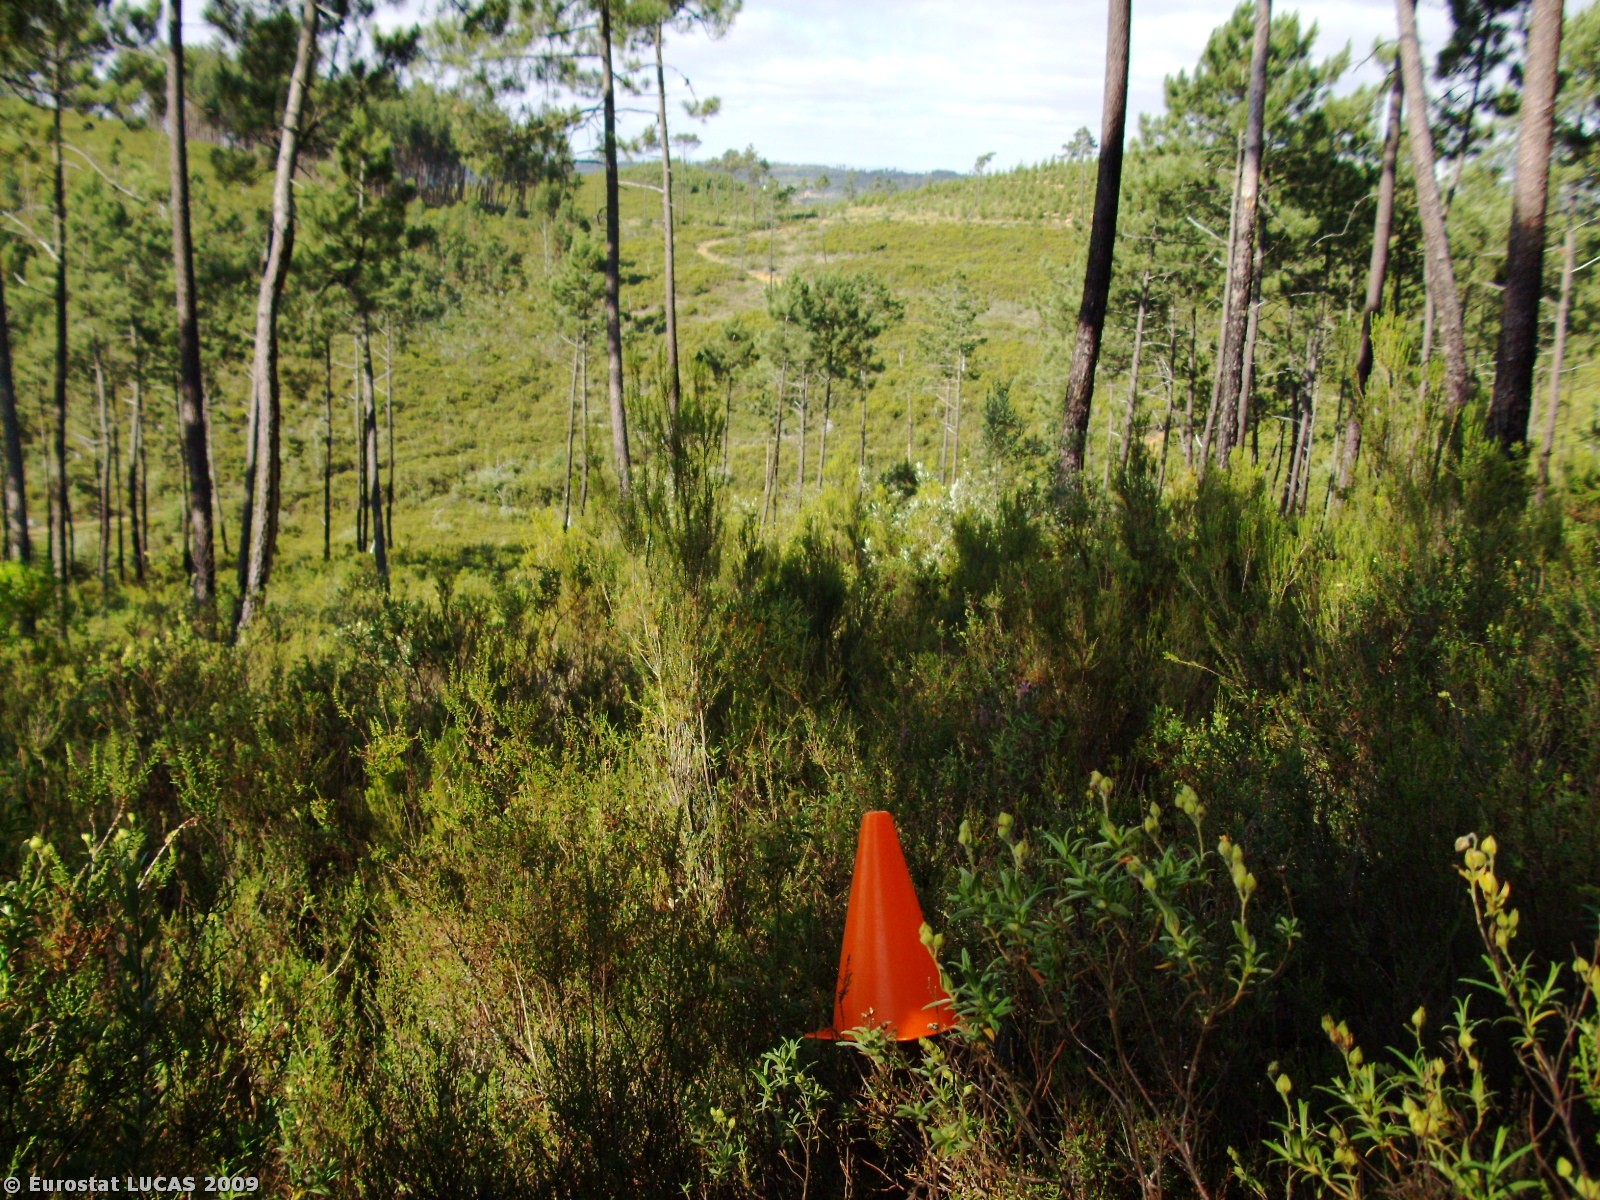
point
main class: Woodland
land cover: Coniferous woodland
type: coniferous forest of the mediterranean region
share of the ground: 50 - 75 %
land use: Forestry
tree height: > 5 m
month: June
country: PT
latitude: 39.8134
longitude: -8.4521
